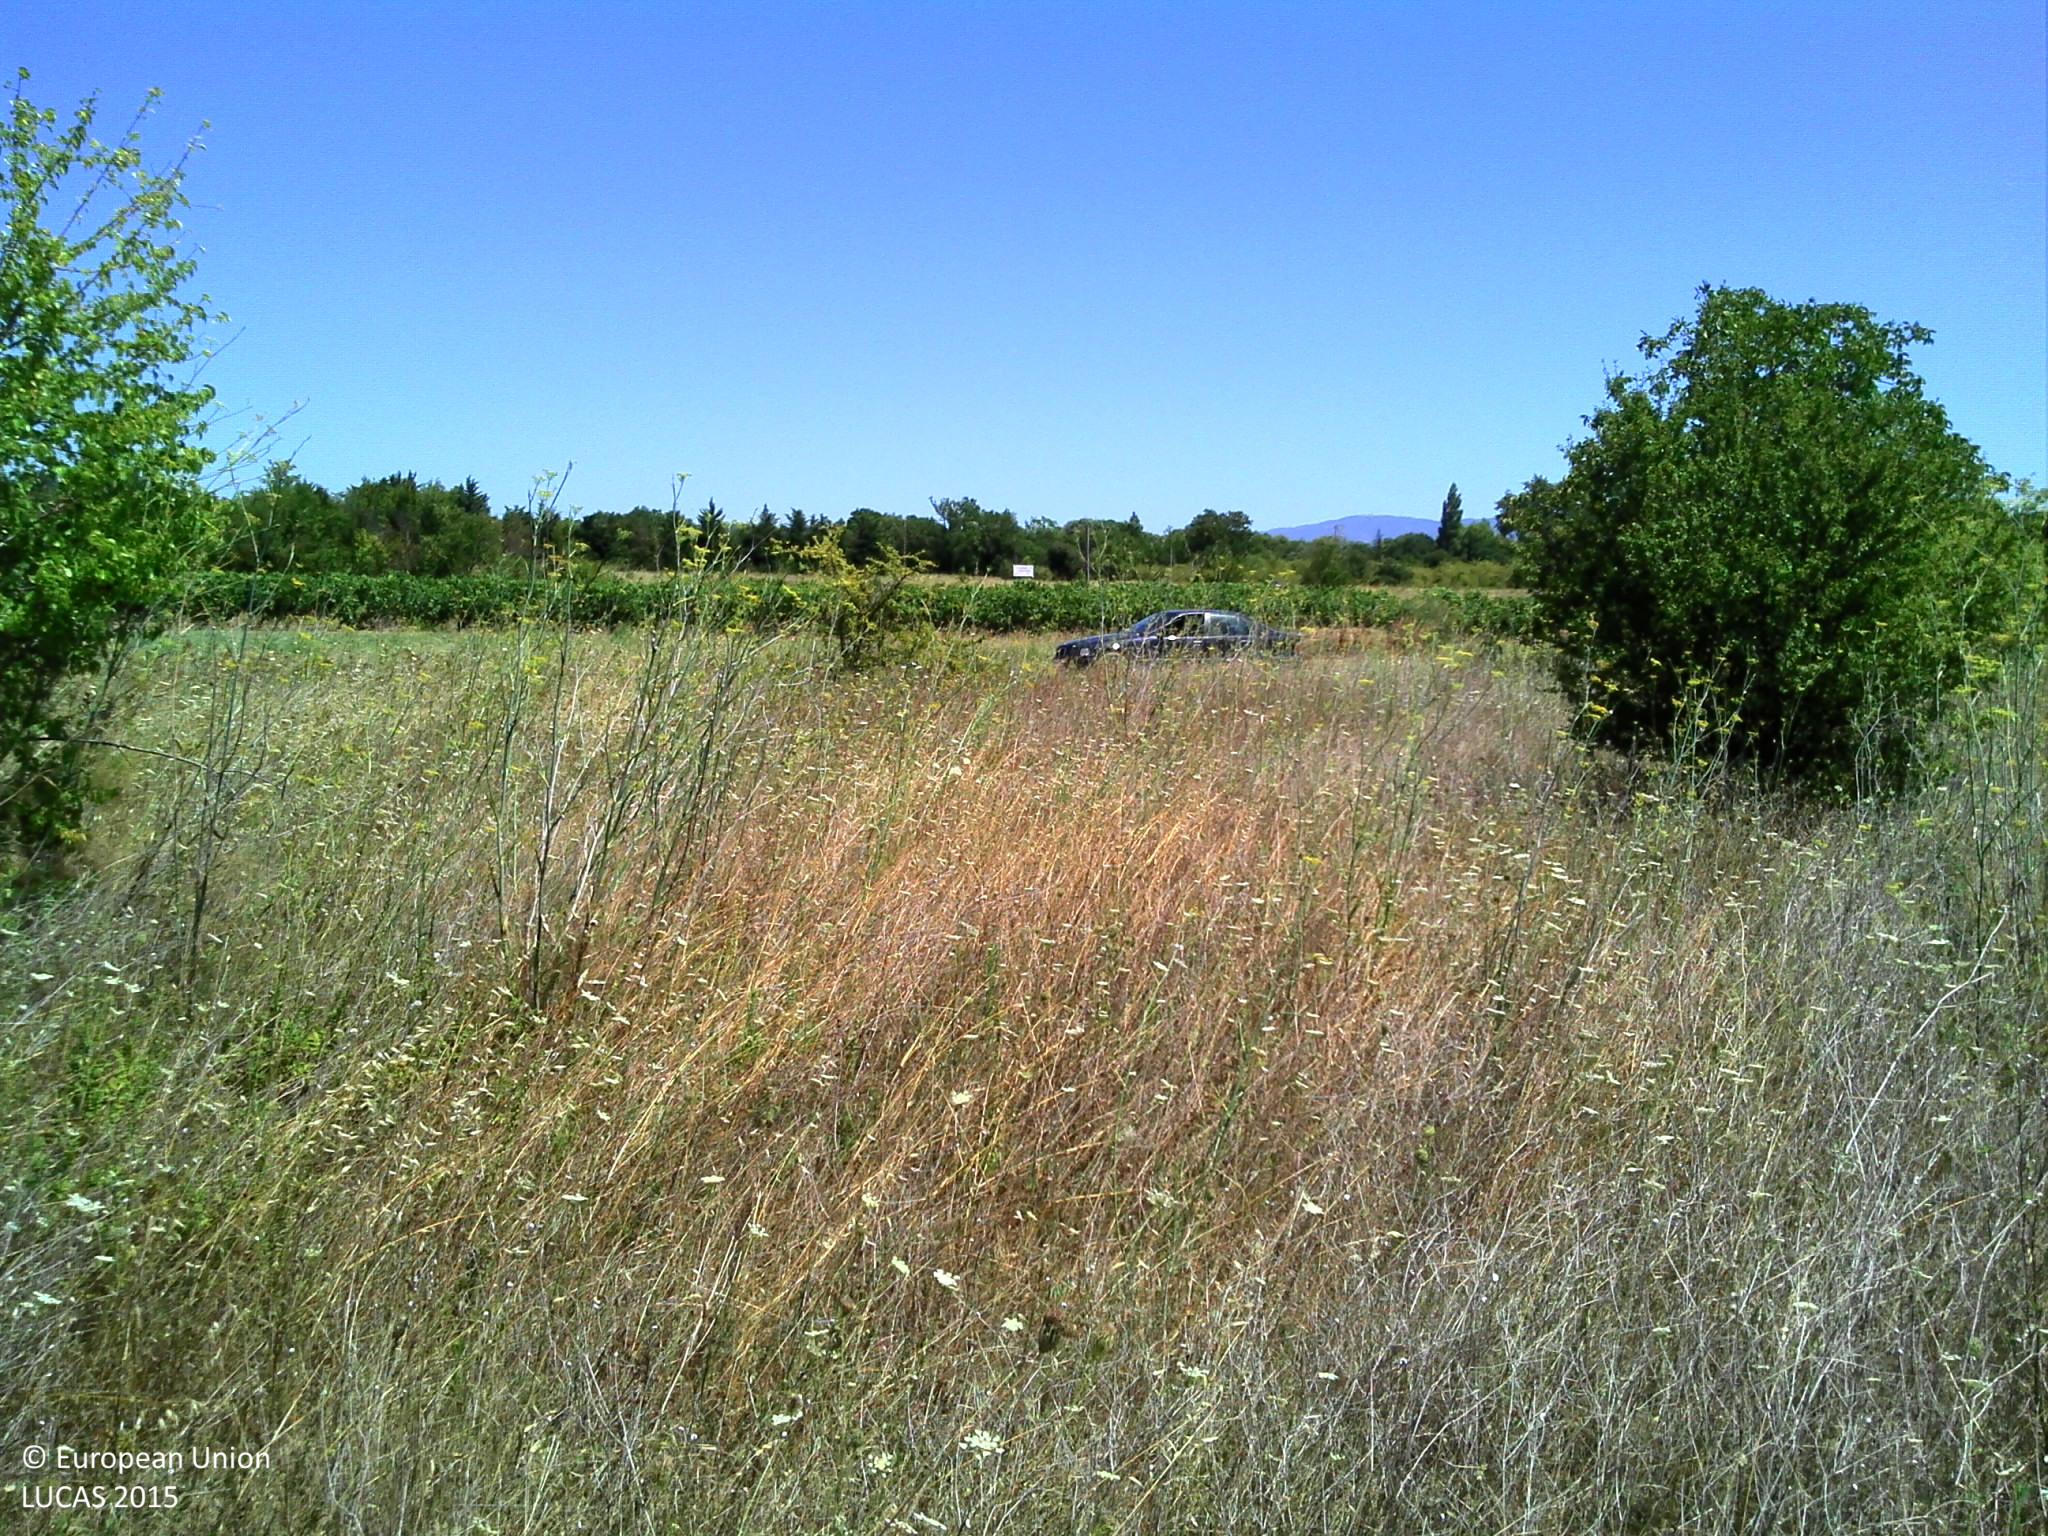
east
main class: Shrubland
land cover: Shrubland with sparse tree cover
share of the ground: > 75 %
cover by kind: herbaceous plants 60 %, shrubs 30 %, broadleaved forest trees 5 %, unconsolidated bare surface 5 %
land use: Semi-natural and natural areas not in use
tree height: < 5 m
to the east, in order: Shrubland with sparse tree cover; Tracks; Grassland without tree/shrub cover; Vineyards; Ditches and canals; Vineyards; Barley; Grassland without tree/shrub cover
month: July
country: FR
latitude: 43.8755
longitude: 5.1428
